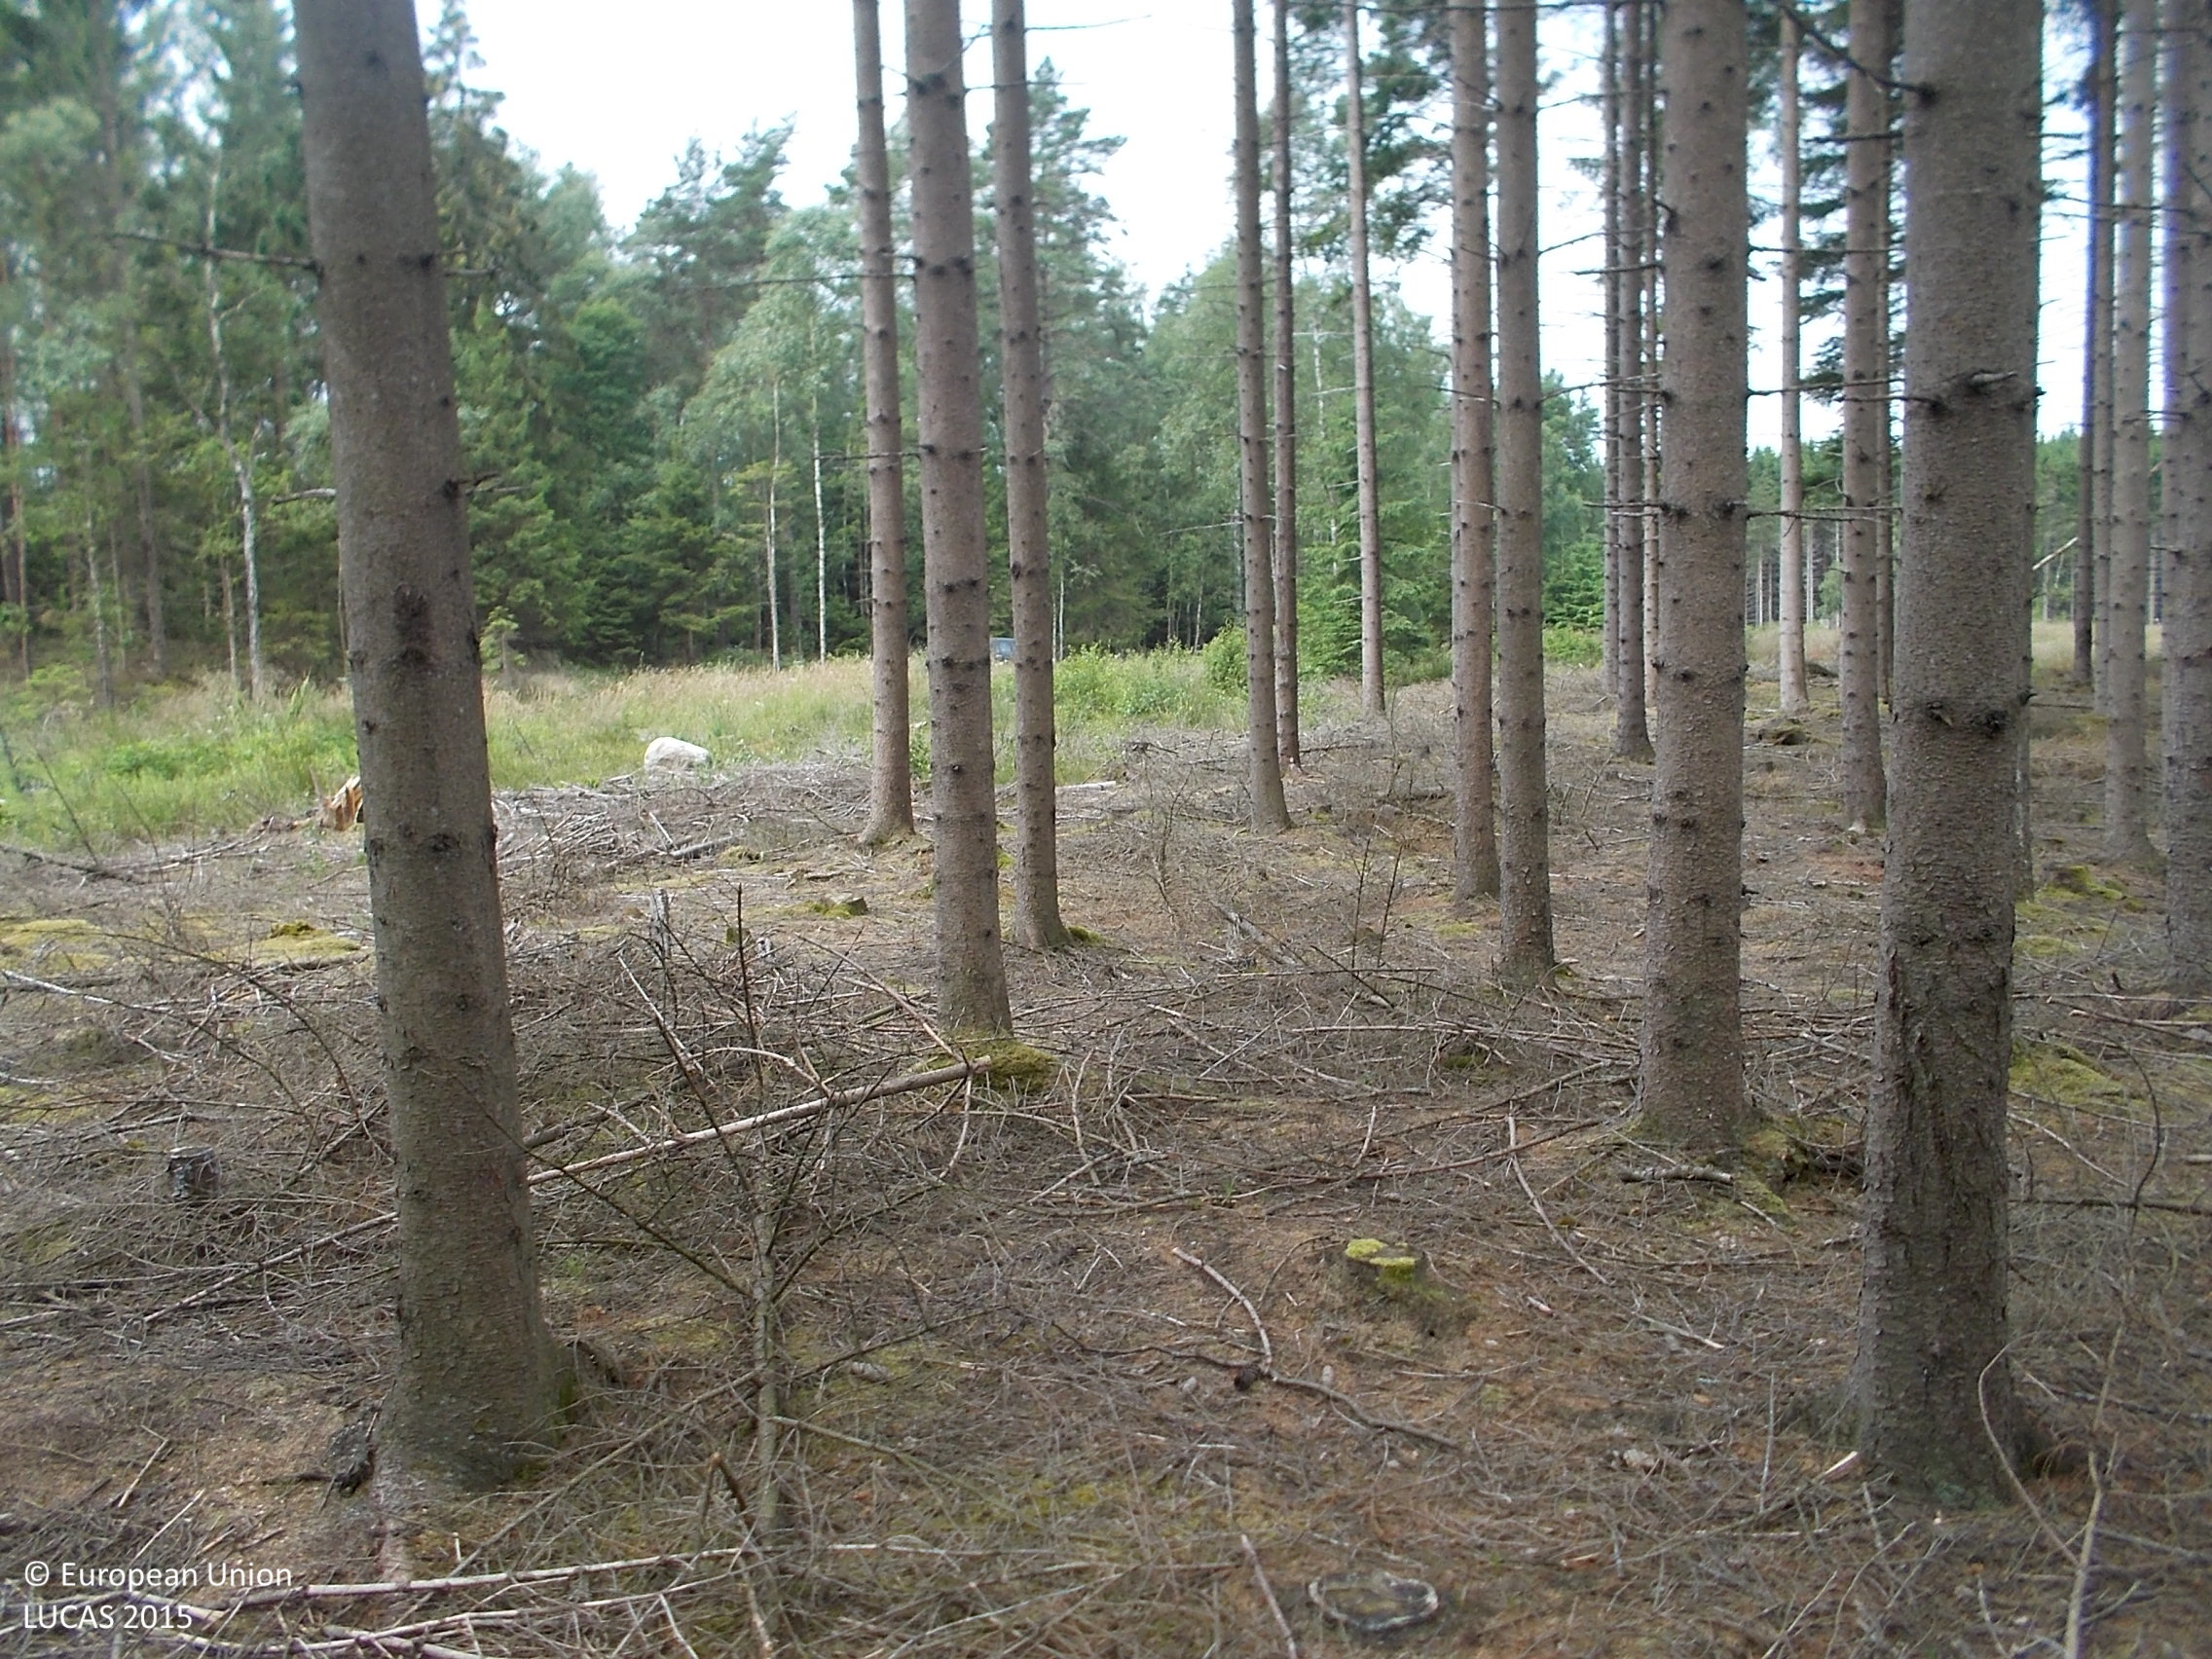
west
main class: Woodland
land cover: Spruce dominated coniferous woodland
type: boreal forest
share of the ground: > 75 %
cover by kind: coniferous forest trees 85 %, lichens and mosses 10 %, herbaceous plants 5 %
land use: Forestry
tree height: > 5 m
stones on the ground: < 10 %
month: July
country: SE
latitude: 57.3008
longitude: 12.2705
